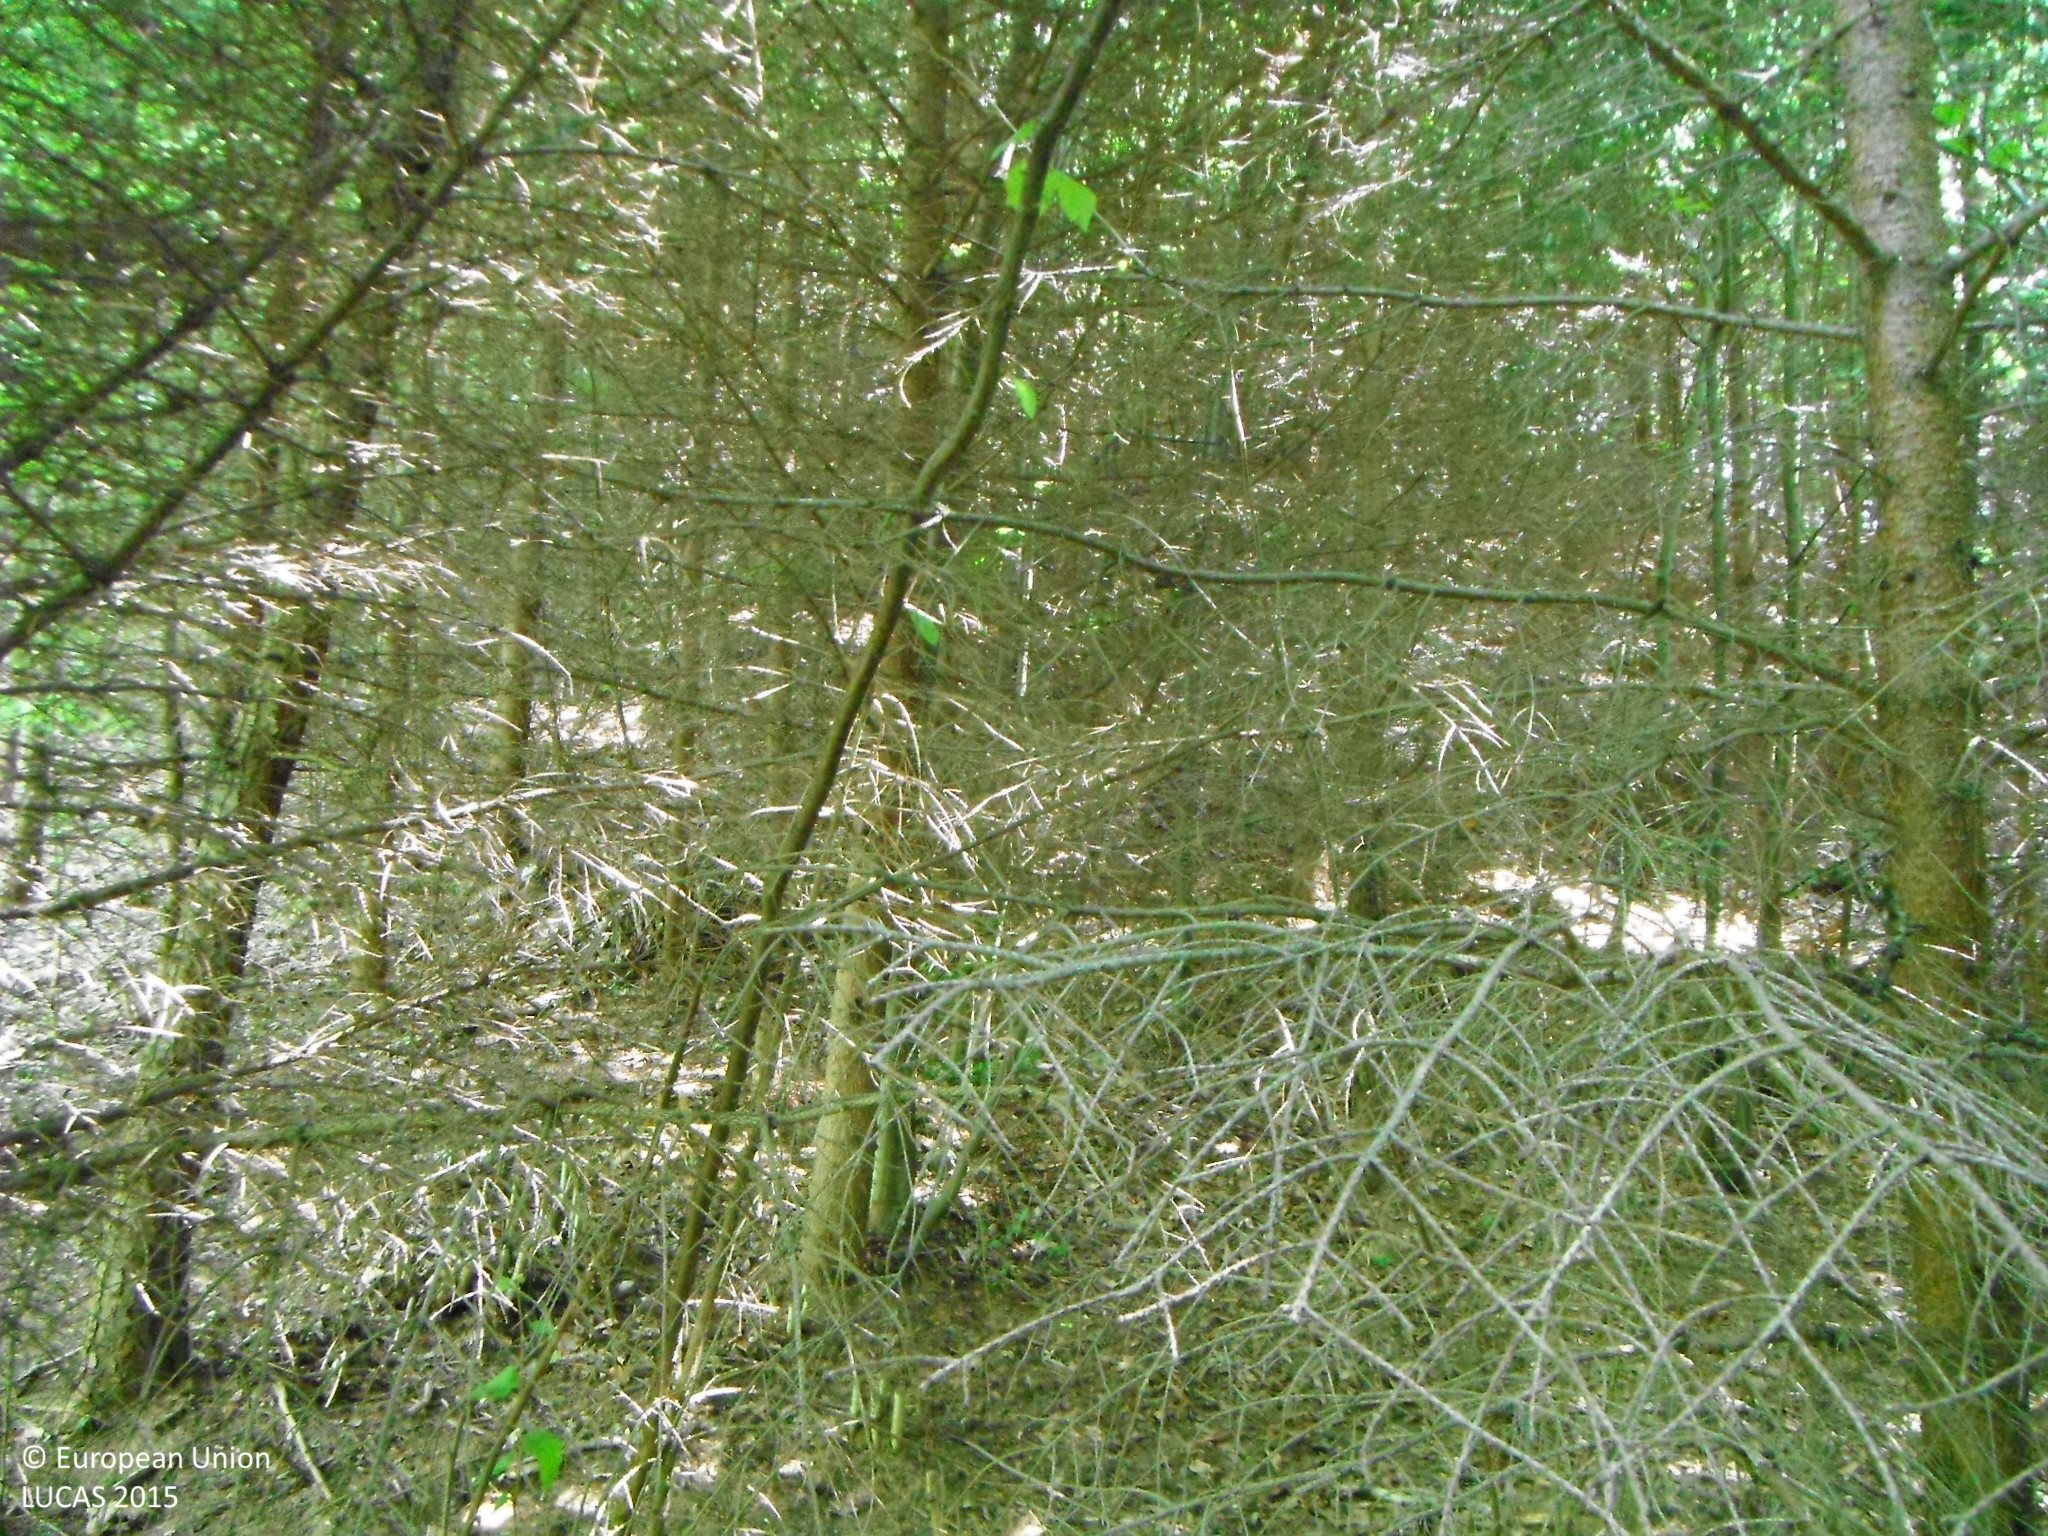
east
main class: Woodland
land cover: Spruce dominated coniferous woodland
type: alpine coniferous forest
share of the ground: > 75 %
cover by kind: coniferous forest trees 100 %
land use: Forestry
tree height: > 5 m
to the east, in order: Spruce dominated coniferous woodland; Spruce dominated mixed woodland; Spontaneously vegetated surfaces; Shrubland without tree cover; Spruce dominated mixed woodland; Grass margins; Tracks; Spruce dominated mixed woodland; Tracks; Broadleaved woodland
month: June
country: SK
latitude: 49.1222
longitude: 19.2180
